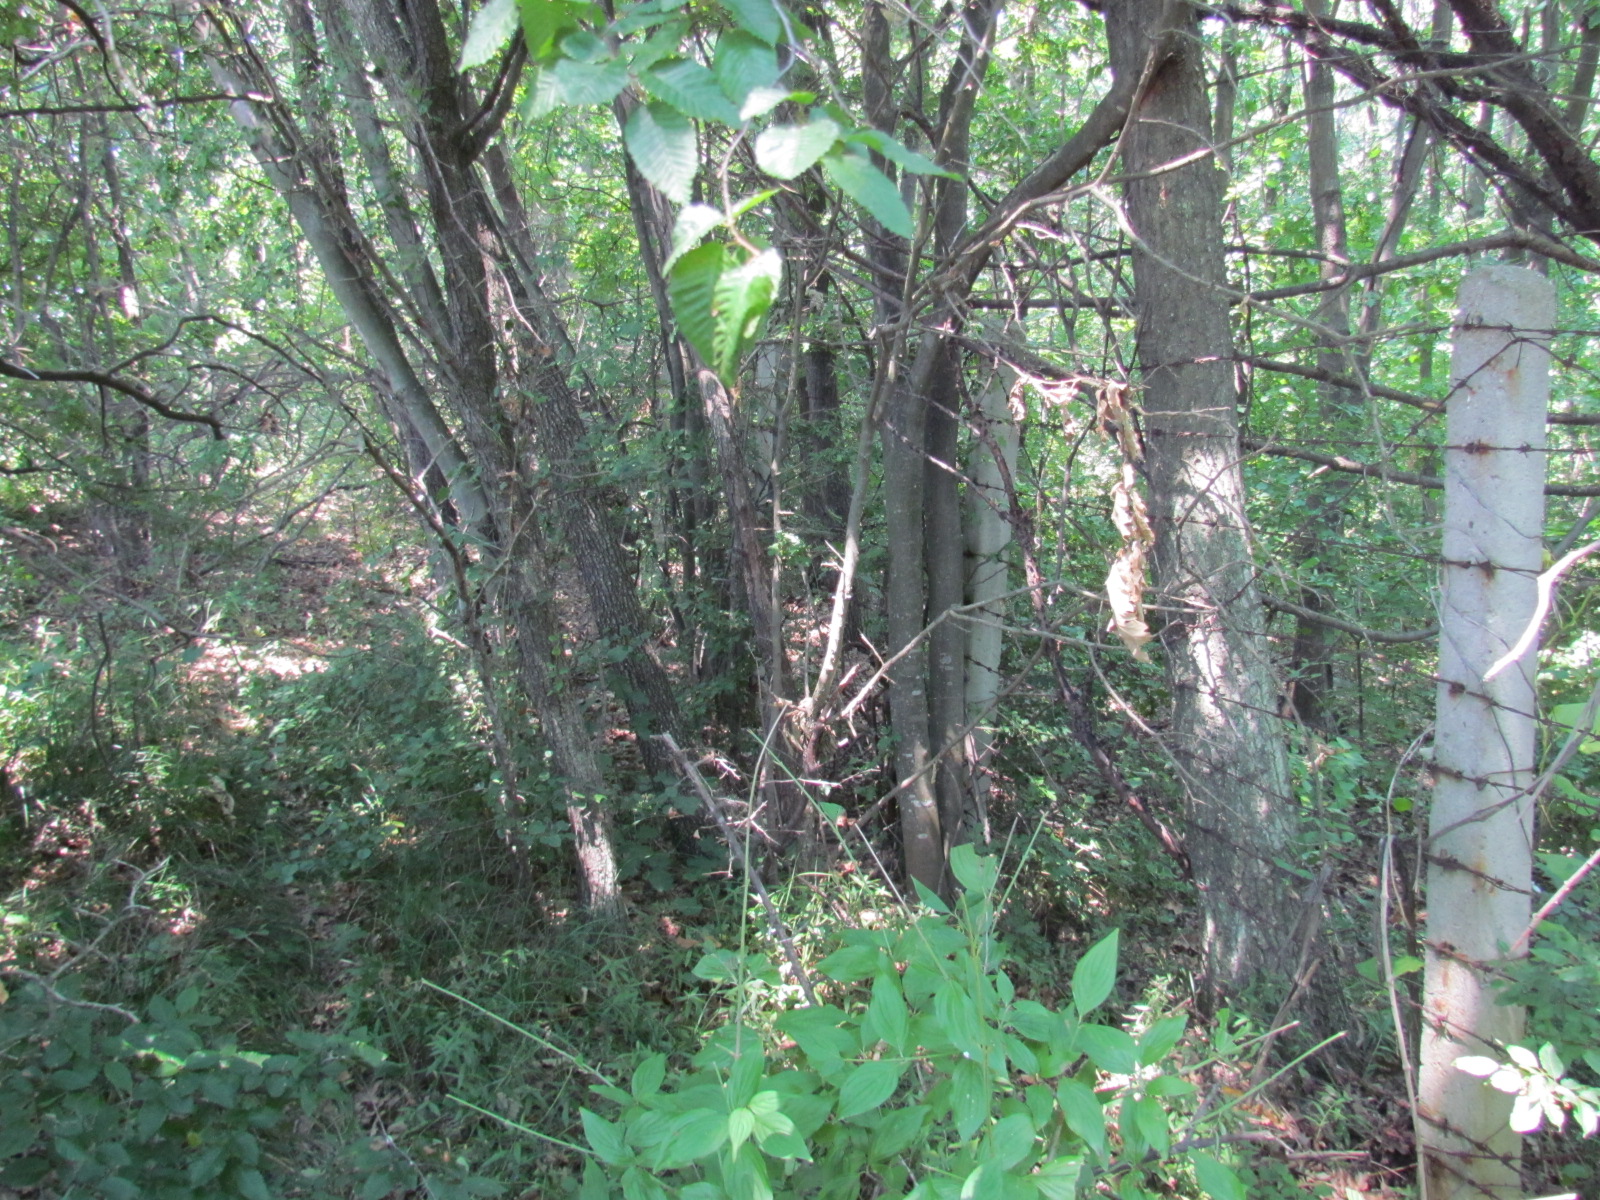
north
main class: Woodland
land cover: Broadleaved woodland
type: acidophilous oak and oak-birch forest
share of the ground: > 75 %
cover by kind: broadleaved forest trees 95 %, shrubs 5 %
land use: Forestry
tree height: > 5 m
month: July
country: BG
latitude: 42.7797
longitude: 27.8929
